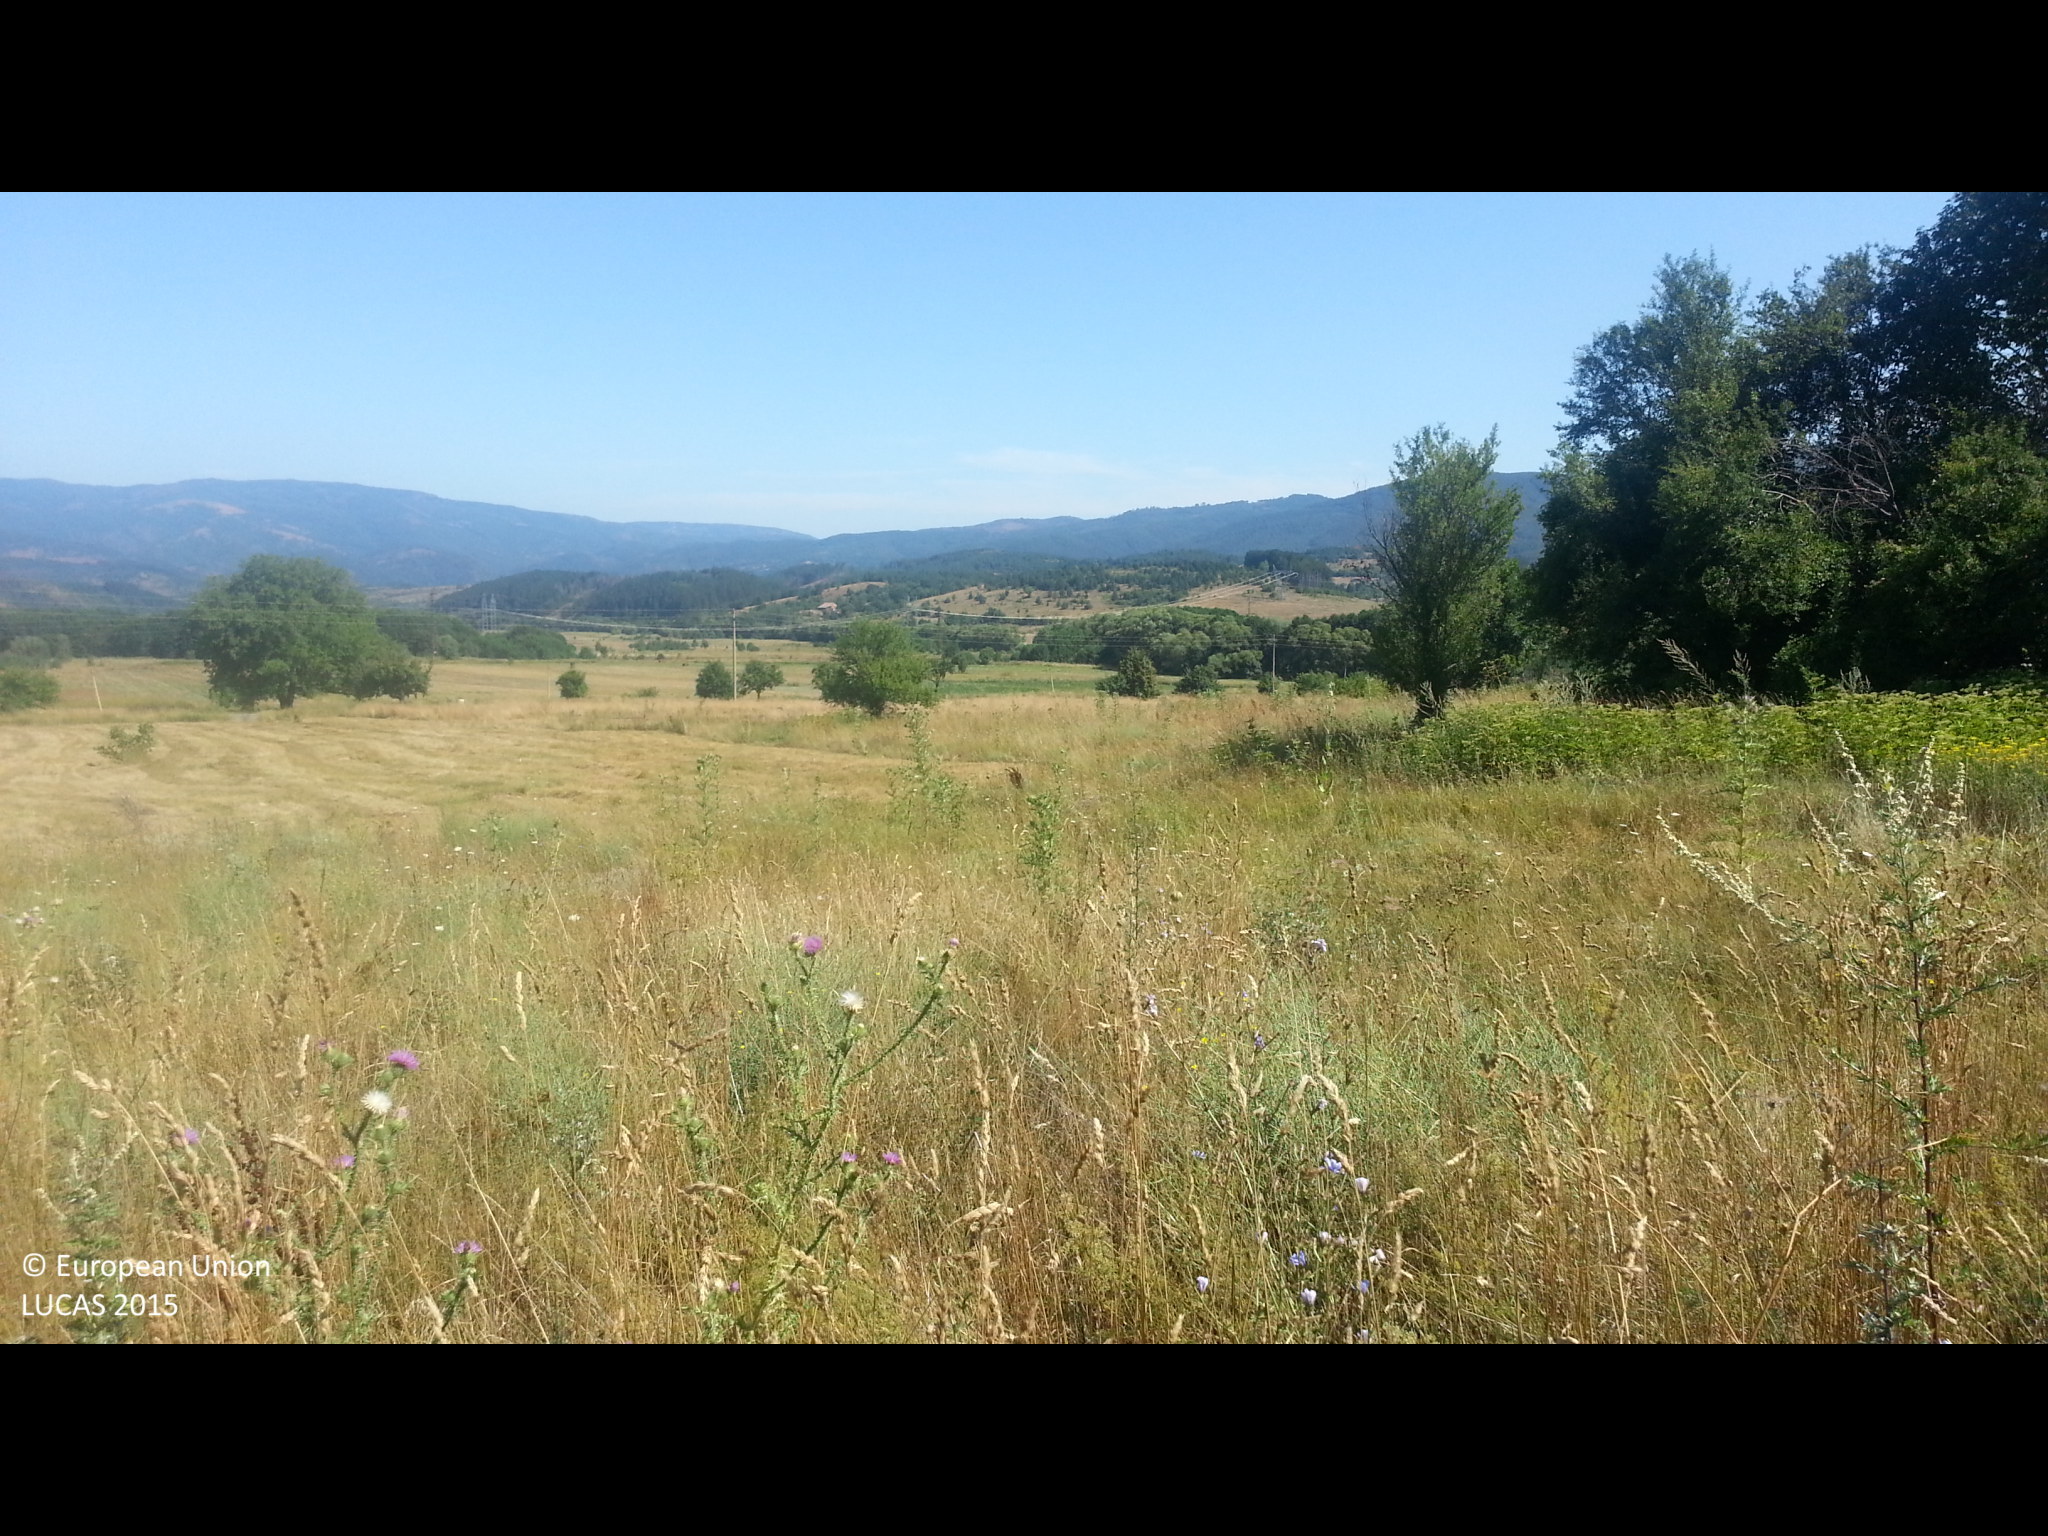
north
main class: Grassland
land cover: Grassland without tree/shrub cover
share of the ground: > 75 %
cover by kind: herbaceous plants 100 %
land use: Semi-natural and natural areas not in use
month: August
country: BG
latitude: 42.2398
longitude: 22.5132
